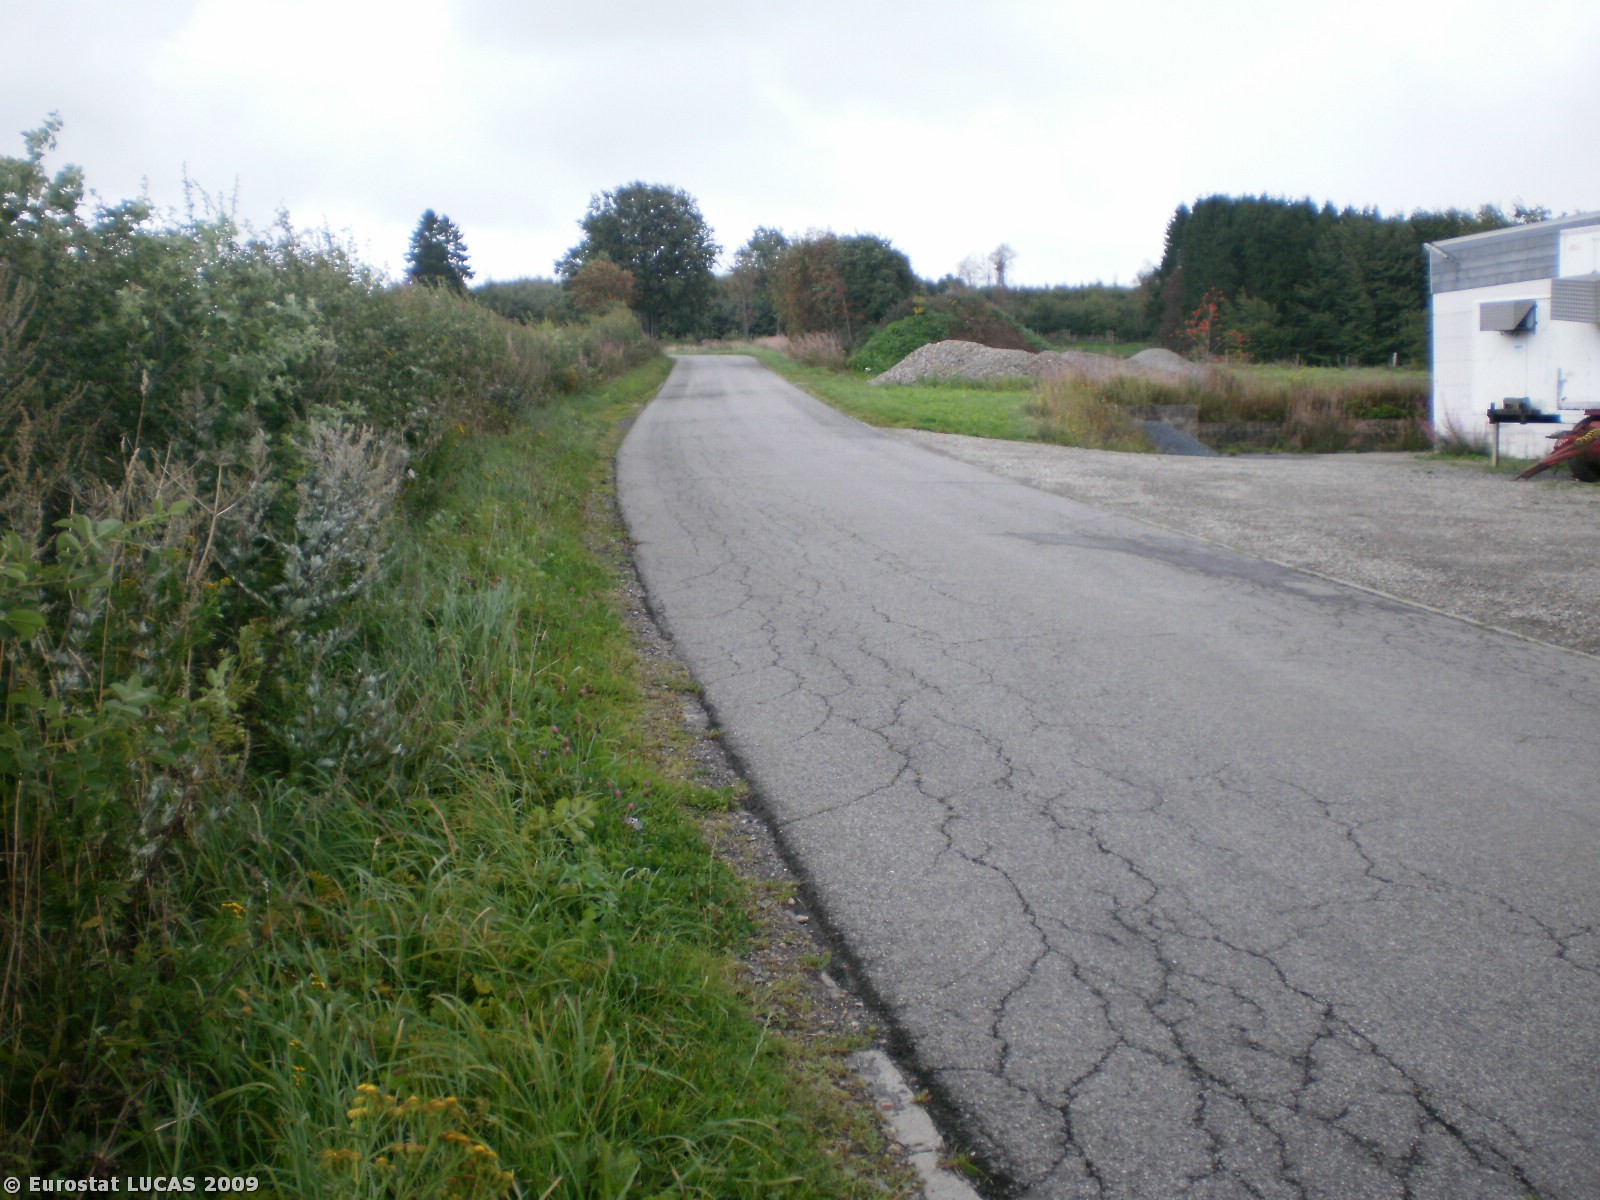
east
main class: Grassland
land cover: Grassland without tree/shrub cover
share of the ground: > 75 %
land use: Agriculture (excluding fallow land and kitchen gardens)
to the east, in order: Grassland without tree/shrub cover; Fences; Grassland without tree/shrub cover; Fences; Abandoned hedges; Grassland without tree/shrub cover; Fences; Grass margins; Paved roads, cycling and walking lanes; Shruby margins; Fences; Single bushes/trees; Grassland without tree/shrub cover
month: September
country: BE
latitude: 50.4113
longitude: 6.2703
